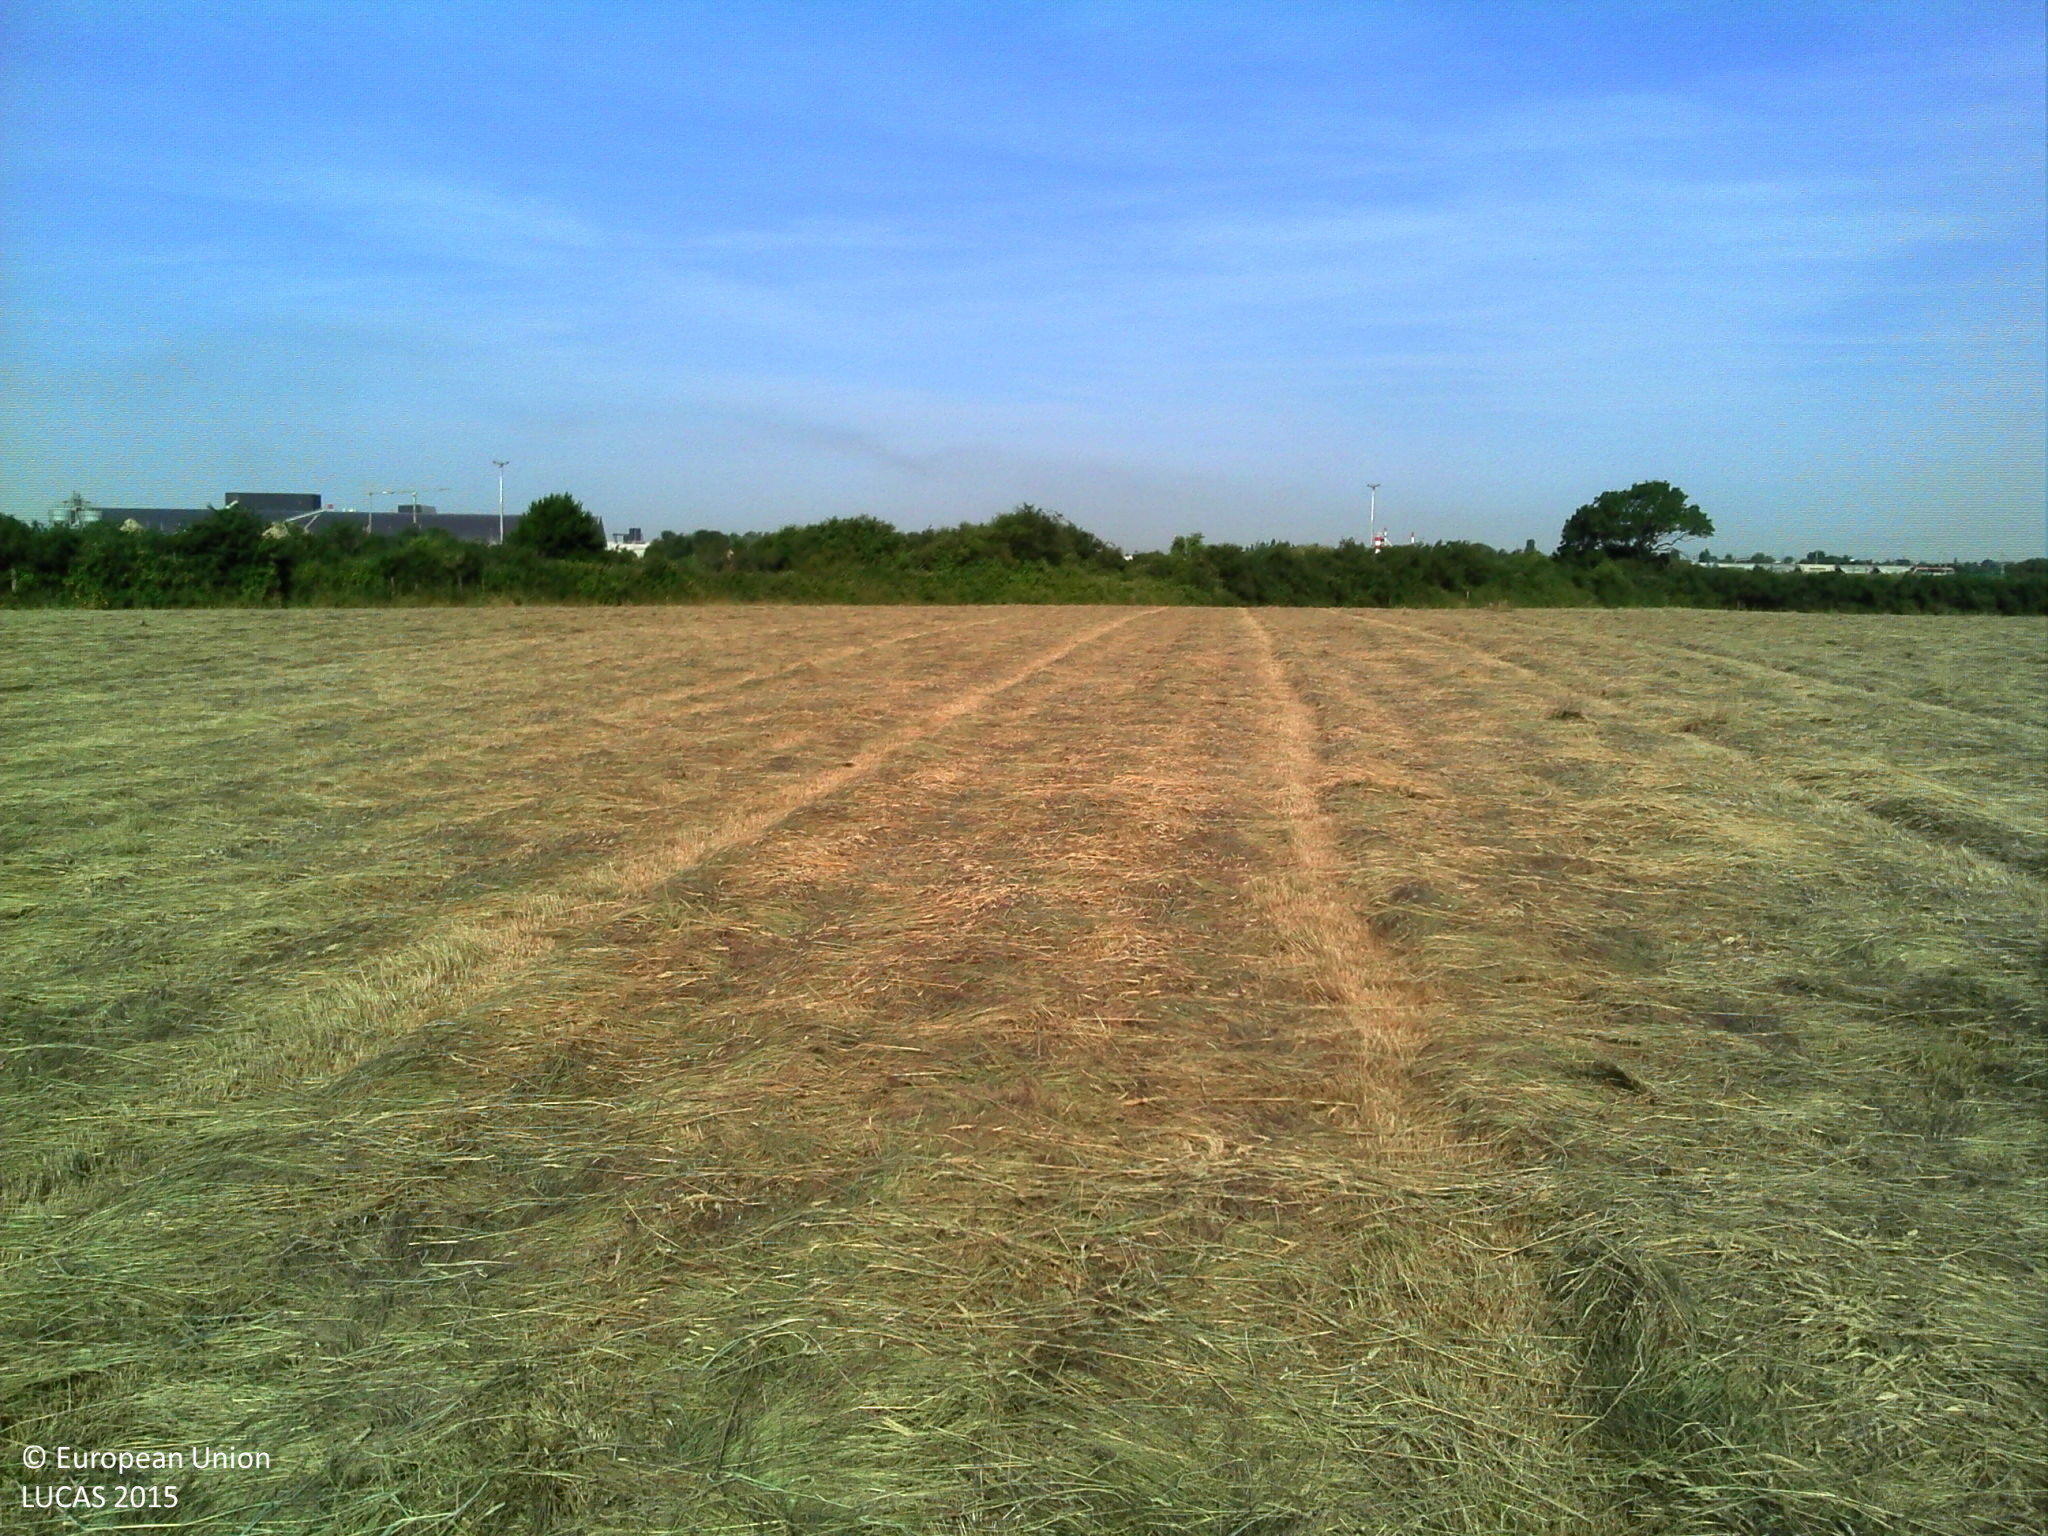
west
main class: Cropland
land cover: Temporary grasslands
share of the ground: > 75 %
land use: Agriculture (excluding fallow land and kitchen gardens)
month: June
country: FR
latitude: 47.3174
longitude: -2.1022
